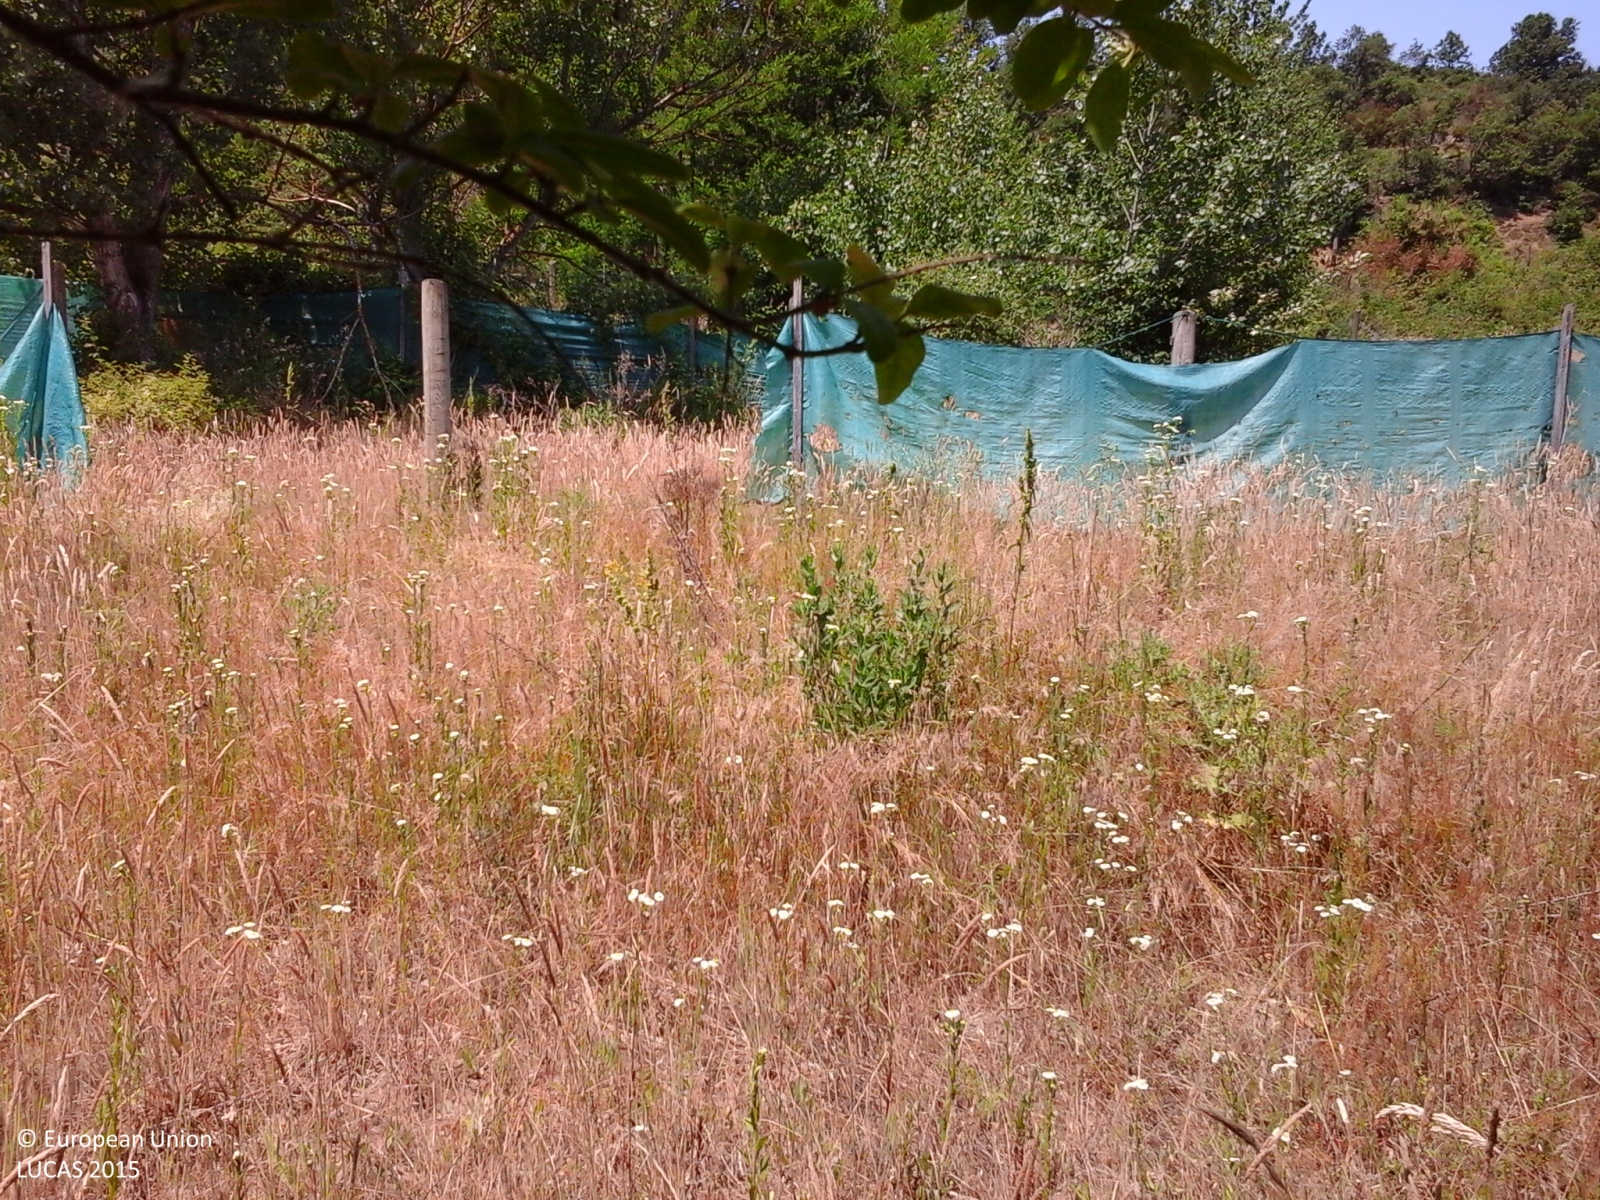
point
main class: Grassland
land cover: Spontaneously vegetated surfaces
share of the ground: > 75 %
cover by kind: herbaceous plants 100 %
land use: Abandoned areas
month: June
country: IT
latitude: 44.7206
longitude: 8.6519
